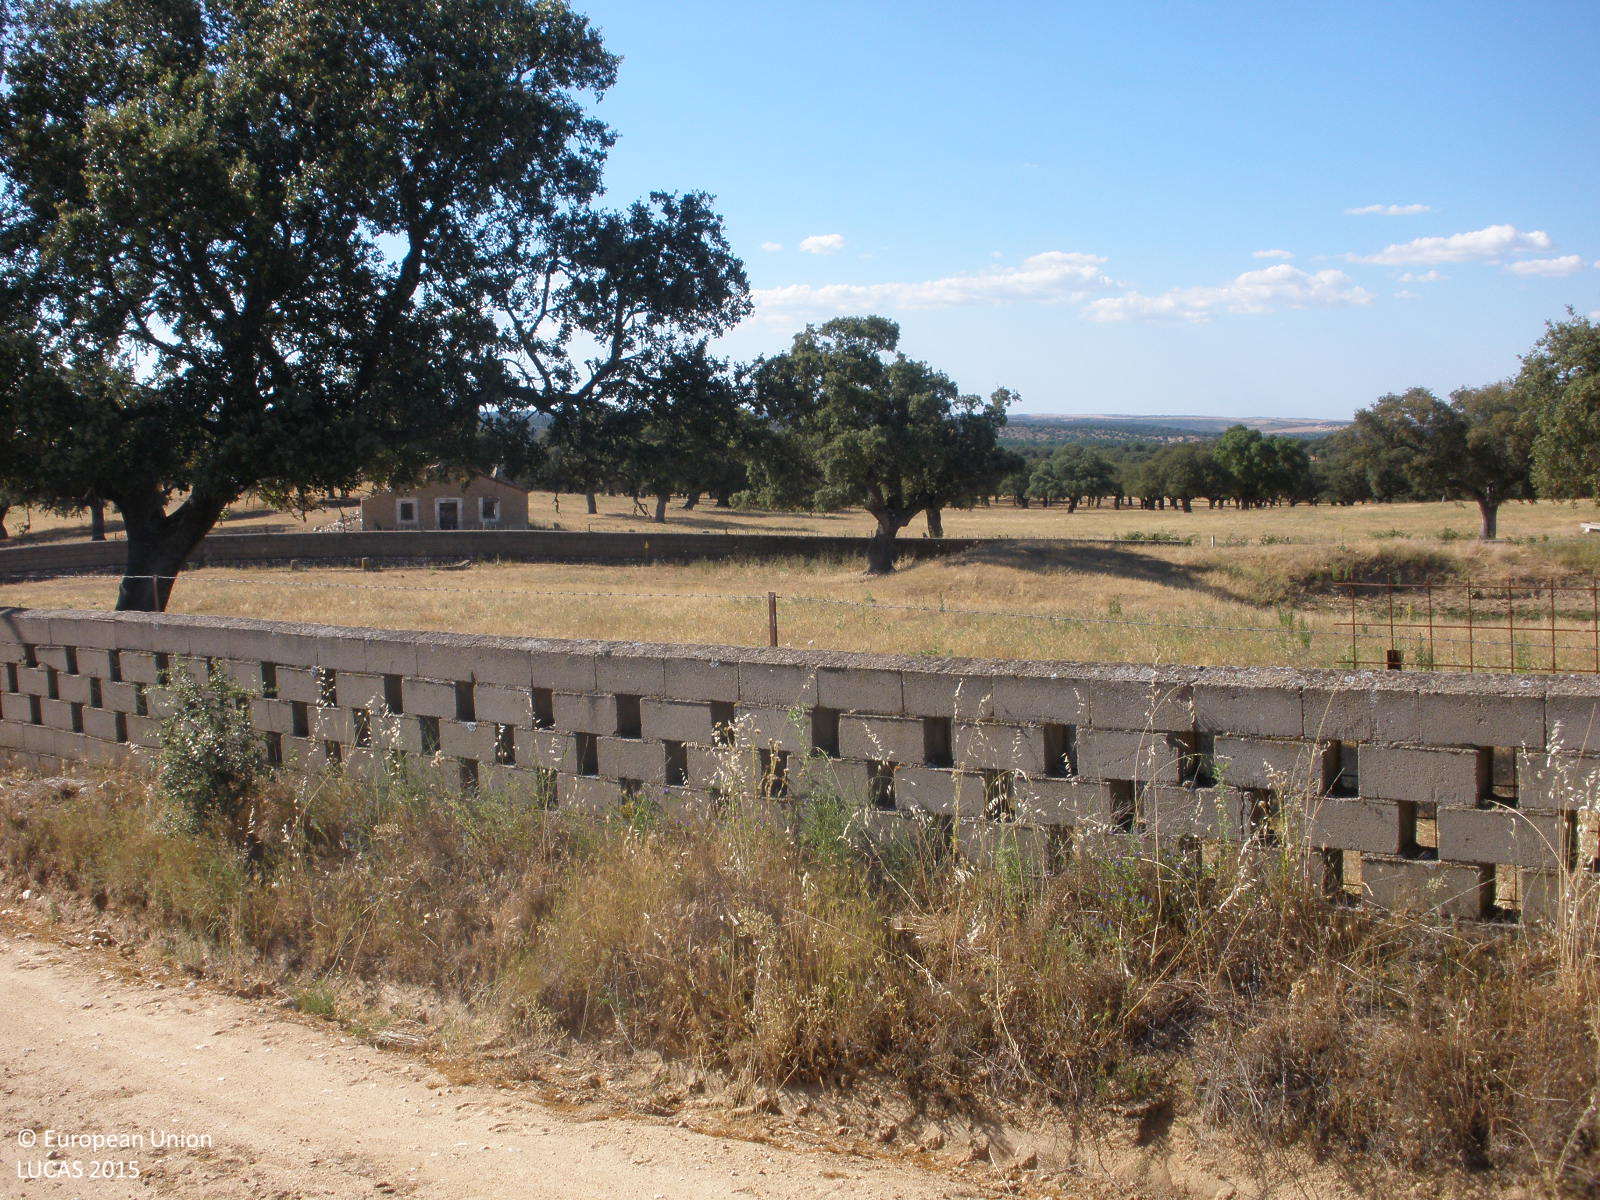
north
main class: Grassland
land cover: Grassland with sparse tree/shrub cover
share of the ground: > 75 %
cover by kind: herbaceous plants 95 %, broadleaved forest trees 5 %
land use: Agriculture (excluding fallow land and kitchen gardens)
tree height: > 5 m
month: June
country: ES
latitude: 40.5276
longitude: -6.6532
